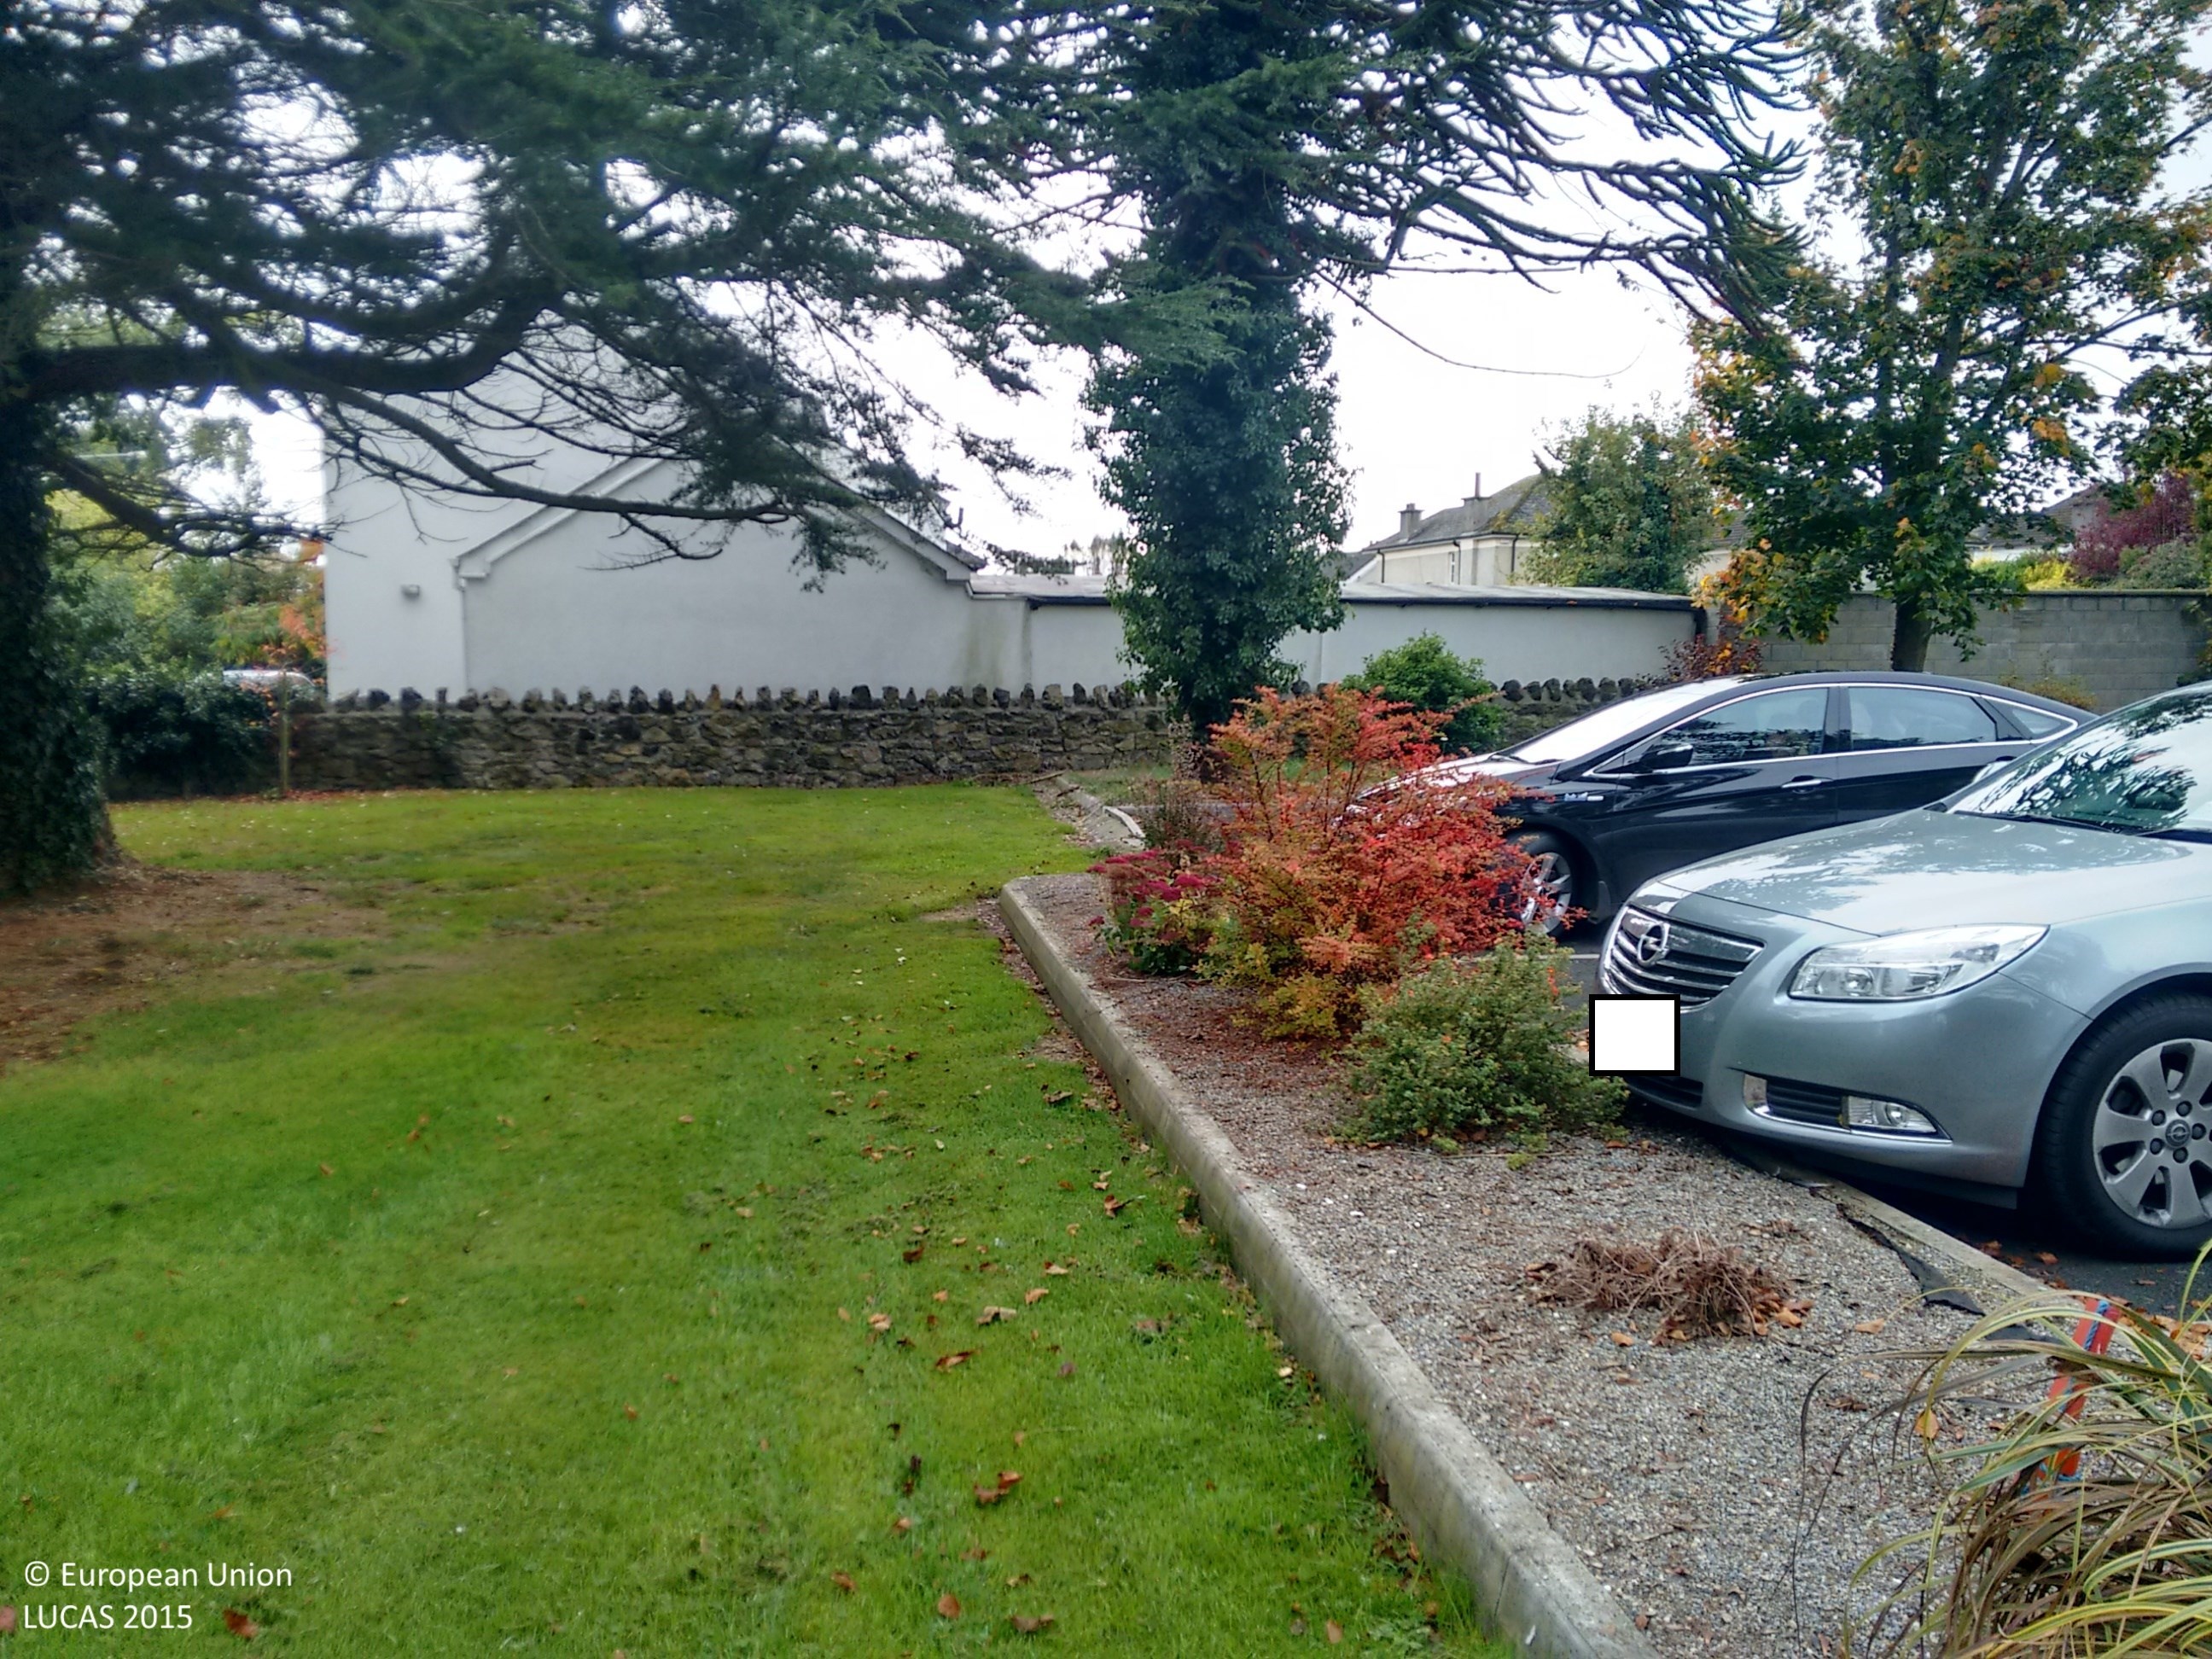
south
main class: Grassland
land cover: Grassland with sparse tree/shrub cover
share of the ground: > 75 %
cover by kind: herbaceous plants 95 %, broadleaved forest trees 5 %
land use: Community services
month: October
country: IE
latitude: 52.6737
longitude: -7.8130
